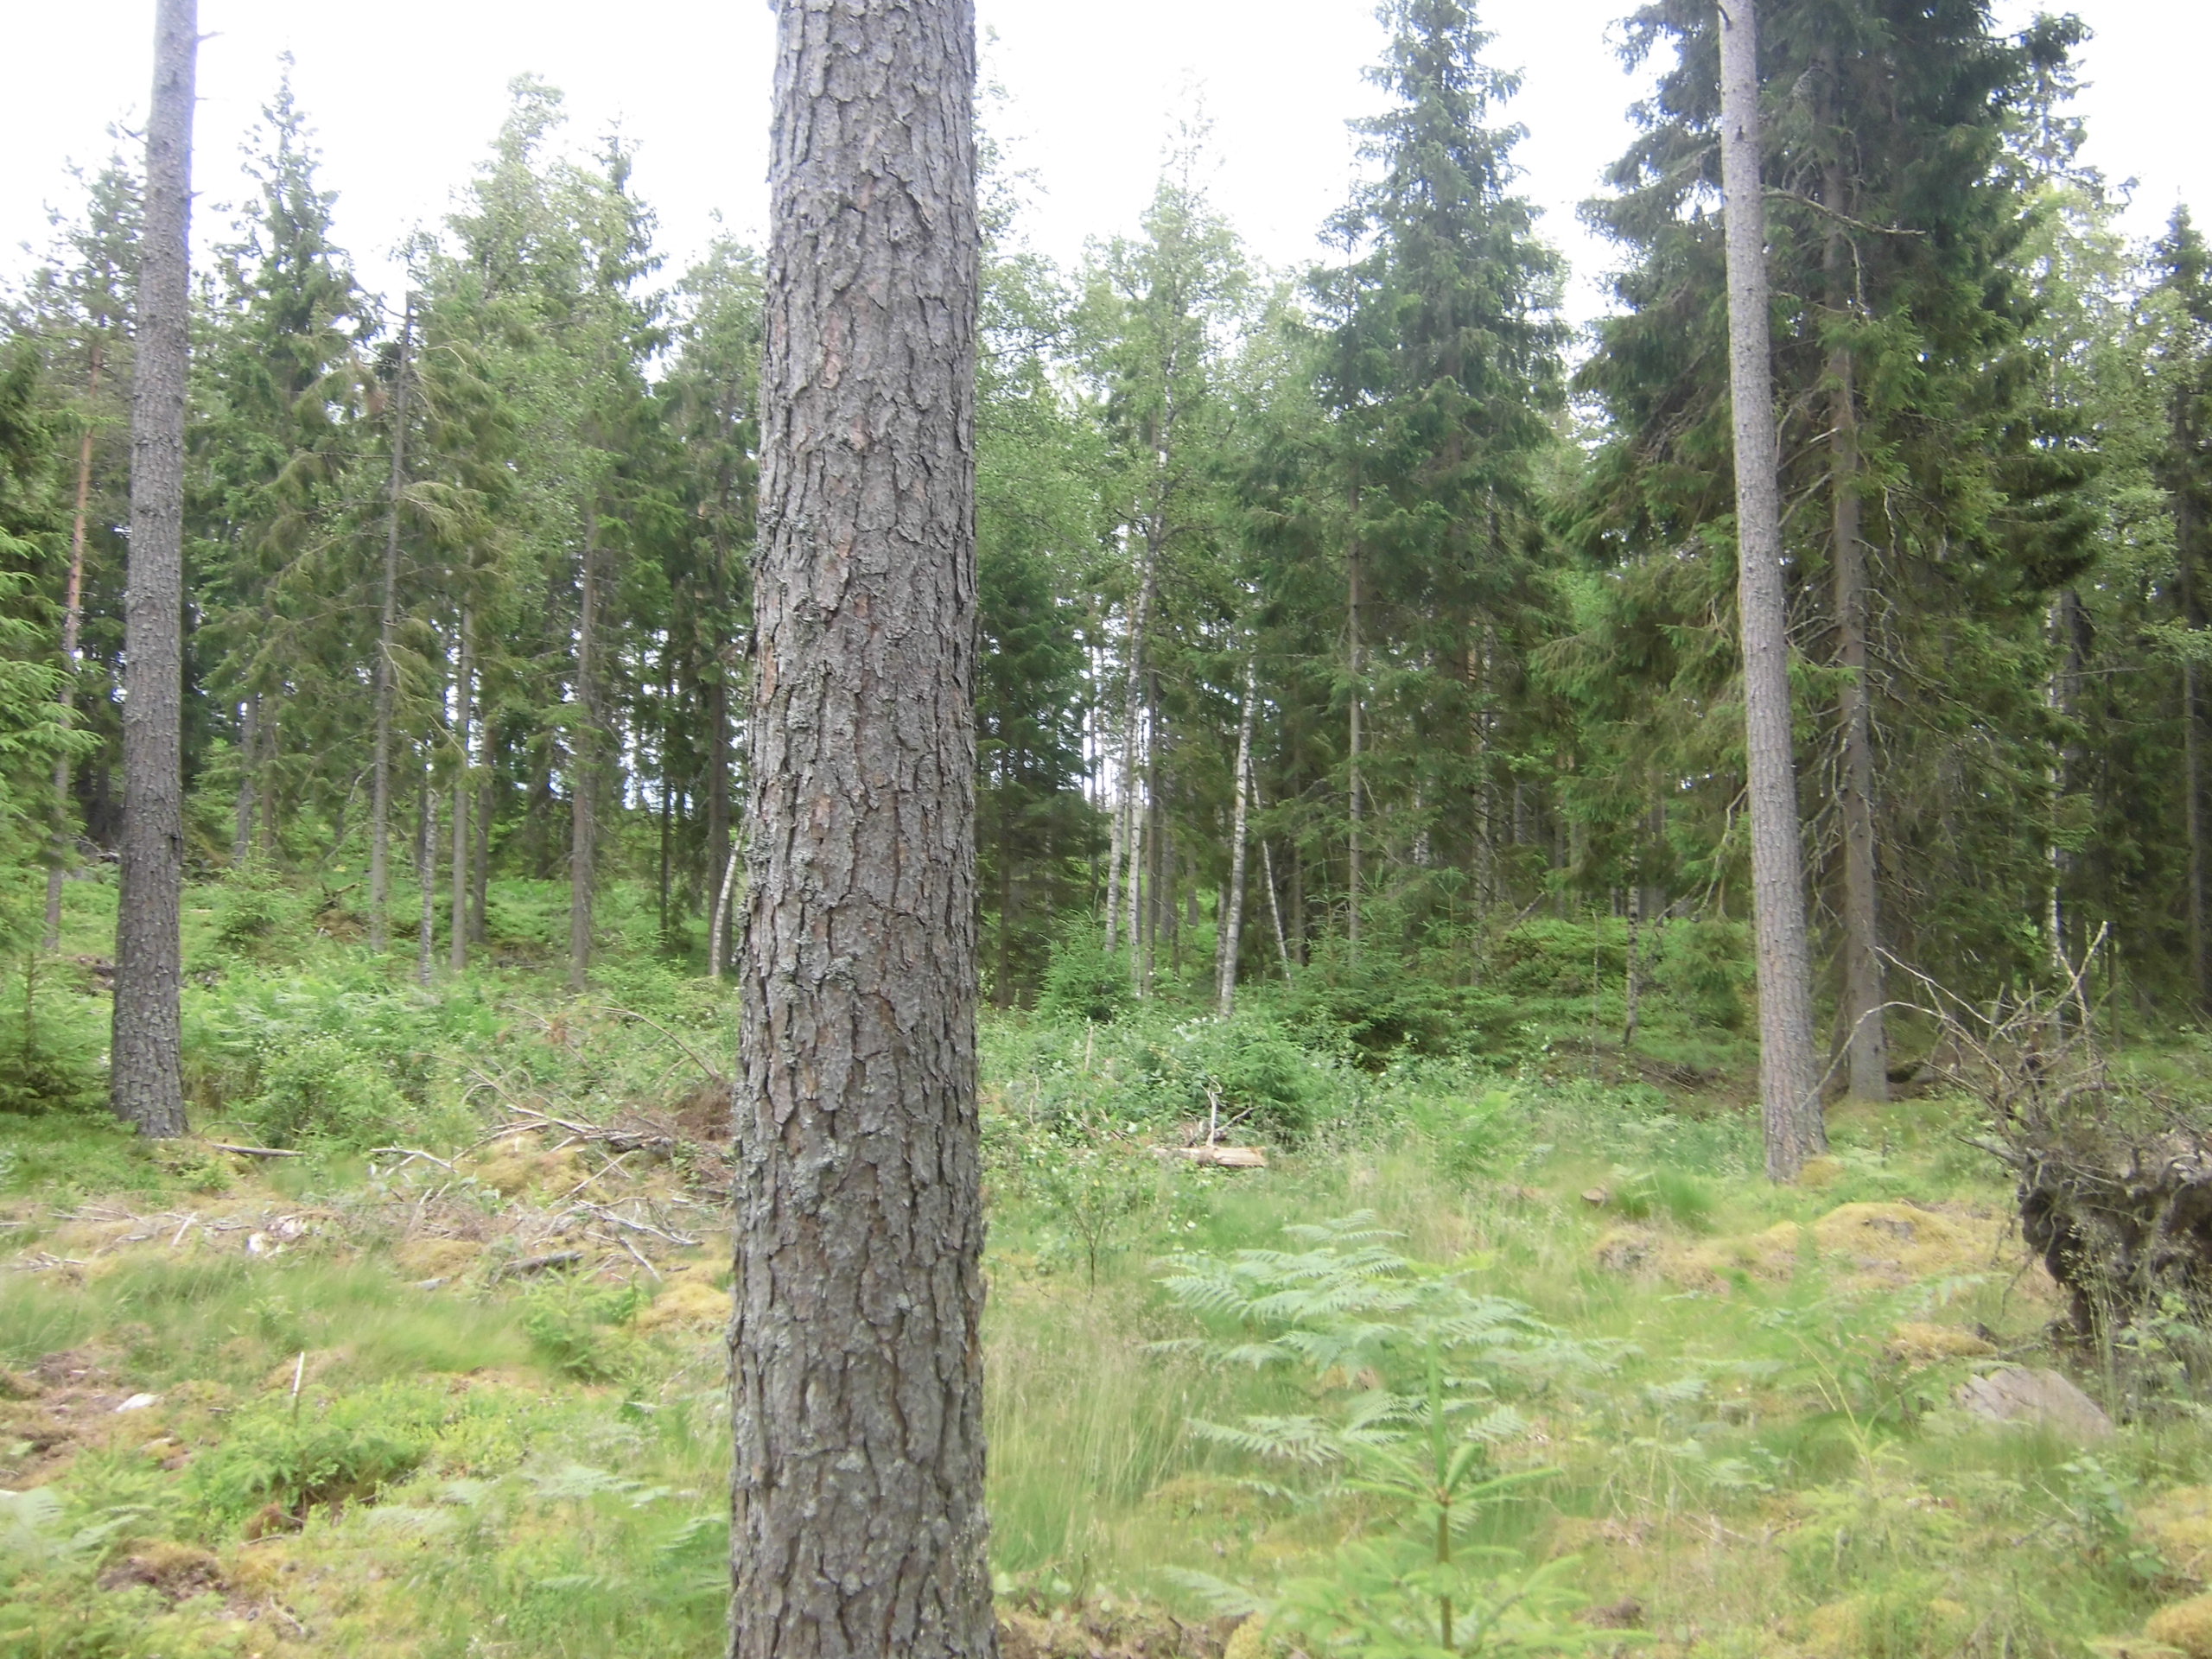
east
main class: Woodland
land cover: Pine dominated coniferous woodland
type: boreal forest
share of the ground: 25 - 50 %
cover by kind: coniferous forest trees 40 %, shrubs 40 %, herbaceous plants 10 %, broadleaved forest trees 5 %, lichens and mosses 5 %
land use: Forestry
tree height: > 5 m
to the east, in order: Pine dominated coniferous woodland; Spruce dominated mixed woodland; Ditches and canals; Spruce dominated mixed woodland; Pine dominated coniferous woodland; Tracks; Pine dominated coniferous woodland; Broadleaved woodland; Spruce dominated mixed woodland; Spruce dominated coniferous woodland
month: July
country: SE
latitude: 57.2749
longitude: 15.1215
